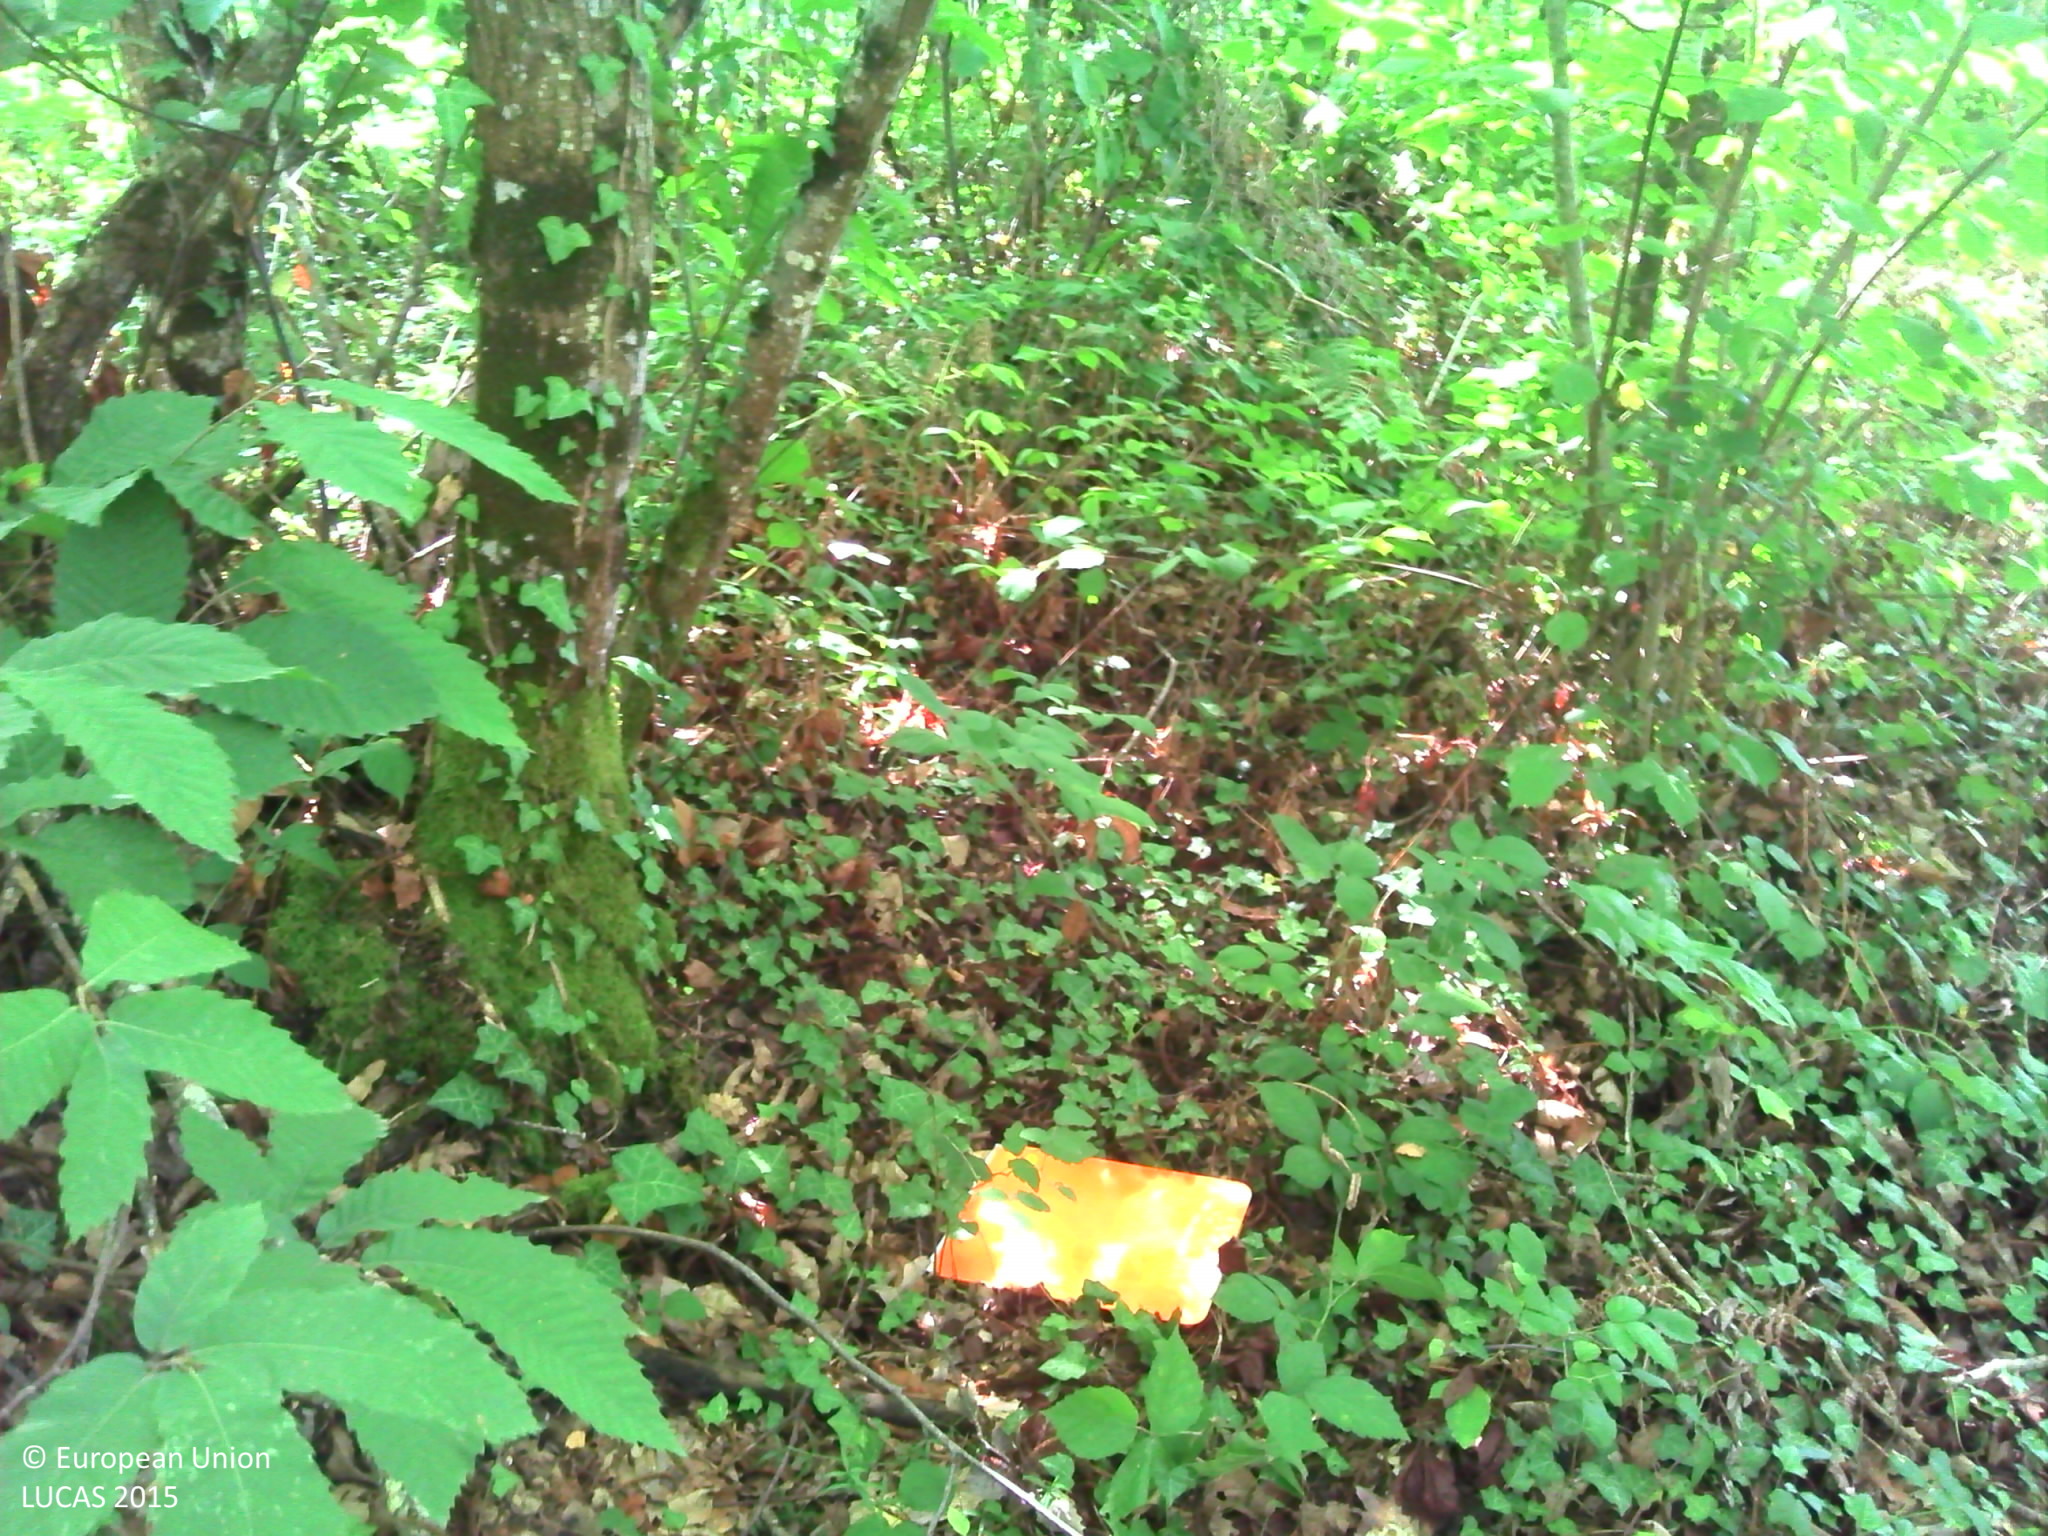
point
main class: Woodland
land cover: Broadleaved woodland
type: mesophytic deciduous forest
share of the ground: > 75 %
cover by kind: broadleaved forest trees 70 %, shrubs 10 %, herbaceous plants 10 %, consolidated bare surface 10 %
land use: Forestry
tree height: > 5 m
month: August
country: FR
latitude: 45.2229
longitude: 0.7315
